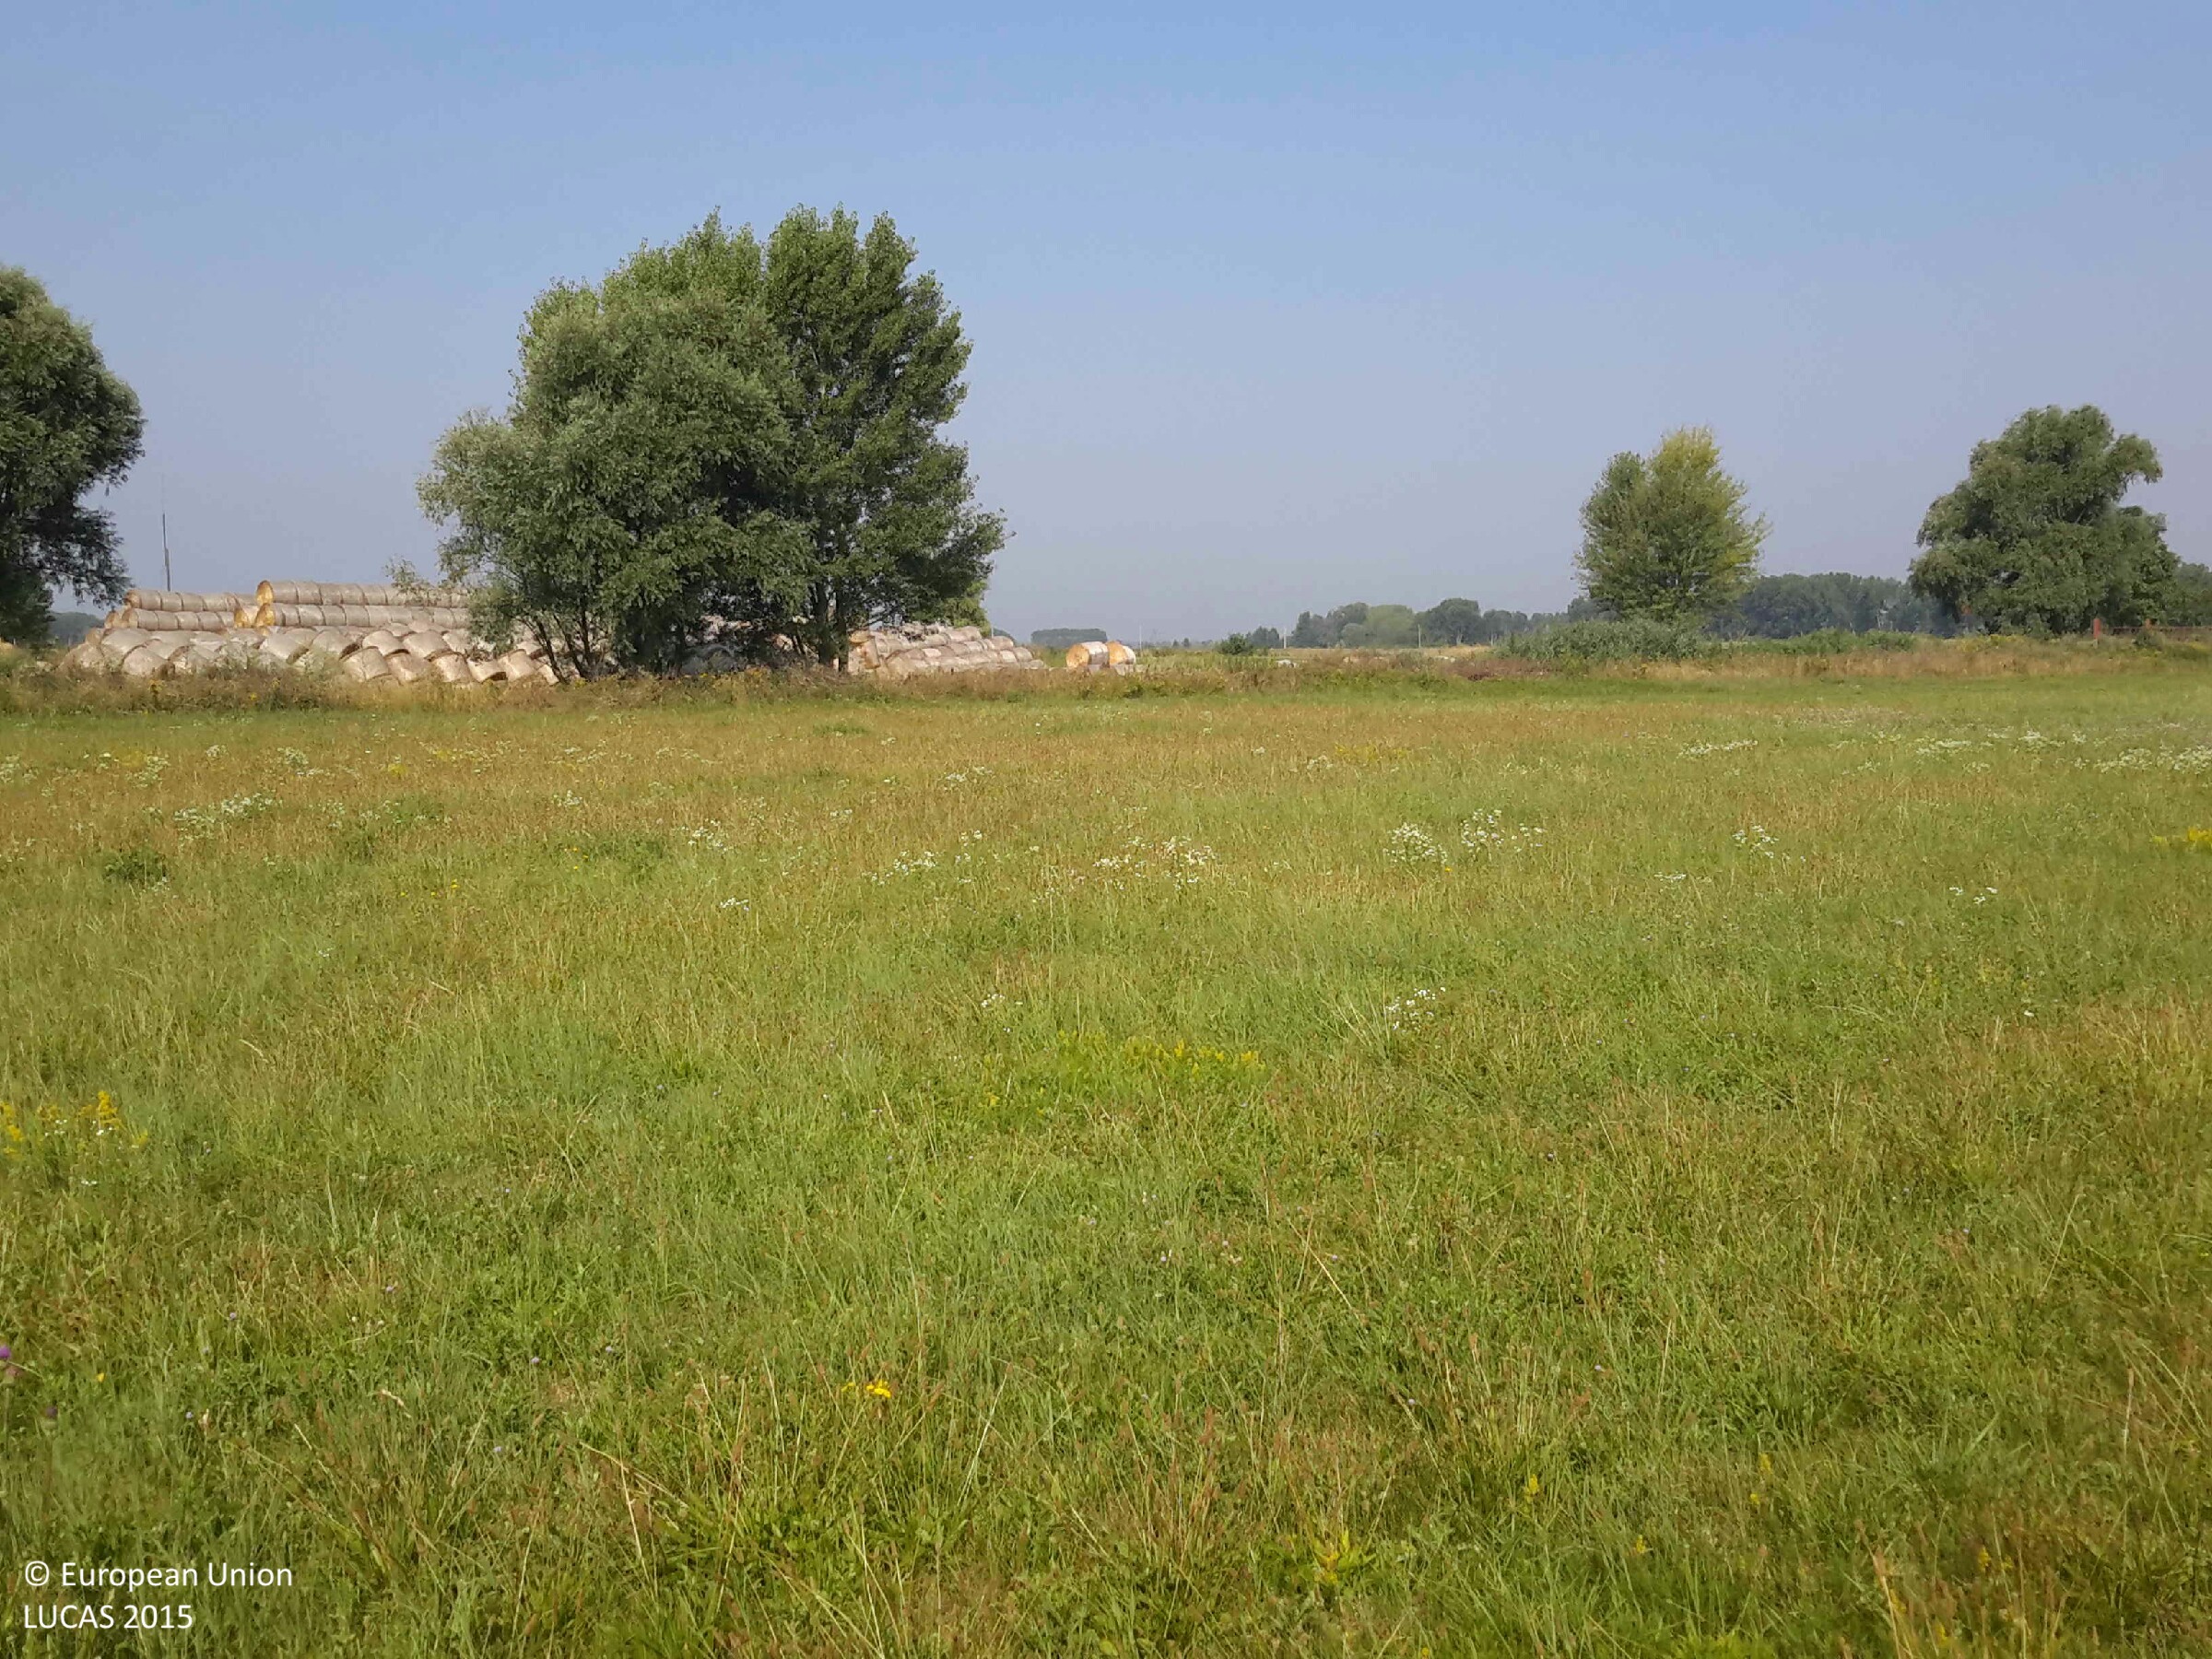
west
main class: Grassland
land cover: Grassland without tree/shrub cover
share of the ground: > 75 %
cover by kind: herbaceous plants 100 %
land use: Agriculture (excluding fallow land and kitchen gardens)
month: August
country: HU
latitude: 47.6961
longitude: 17.2427
